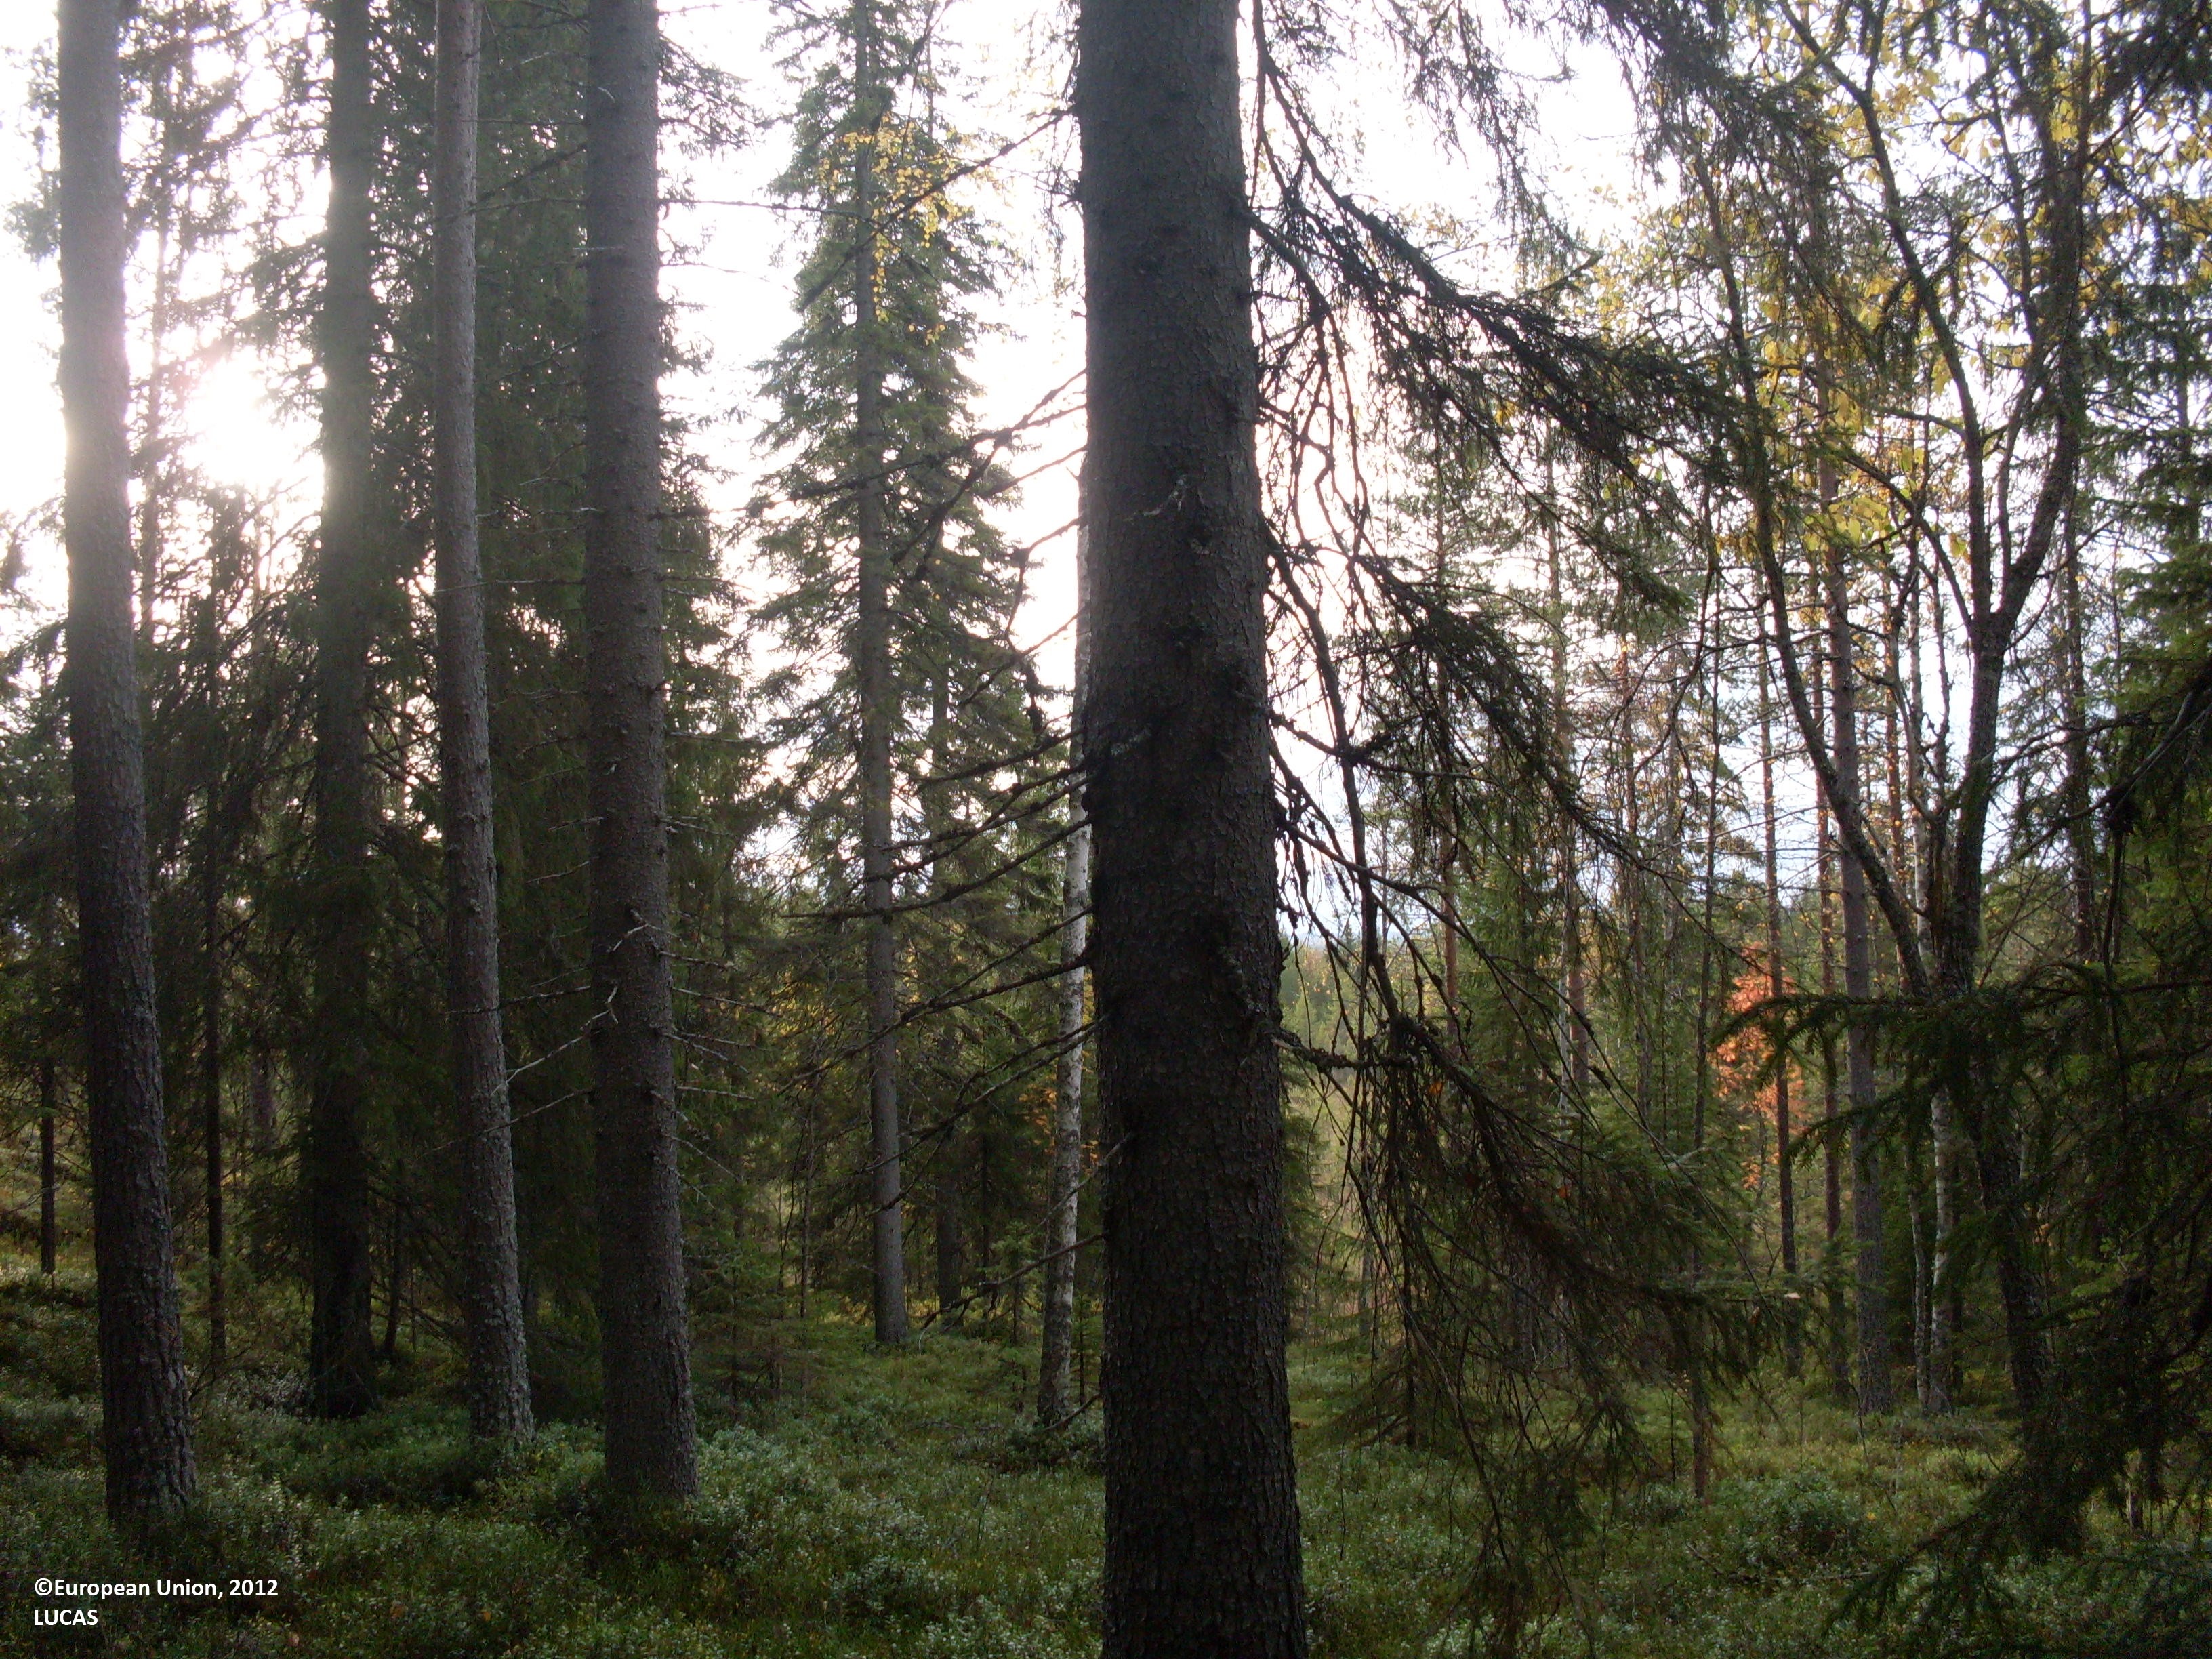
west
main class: Woodland
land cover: Spruce dominated mixed woodland
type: boreal forest
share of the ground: > 75 %
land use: Forestry
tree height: > 5 m
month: September
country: FI
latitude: 64.3924
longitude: 28.5309
